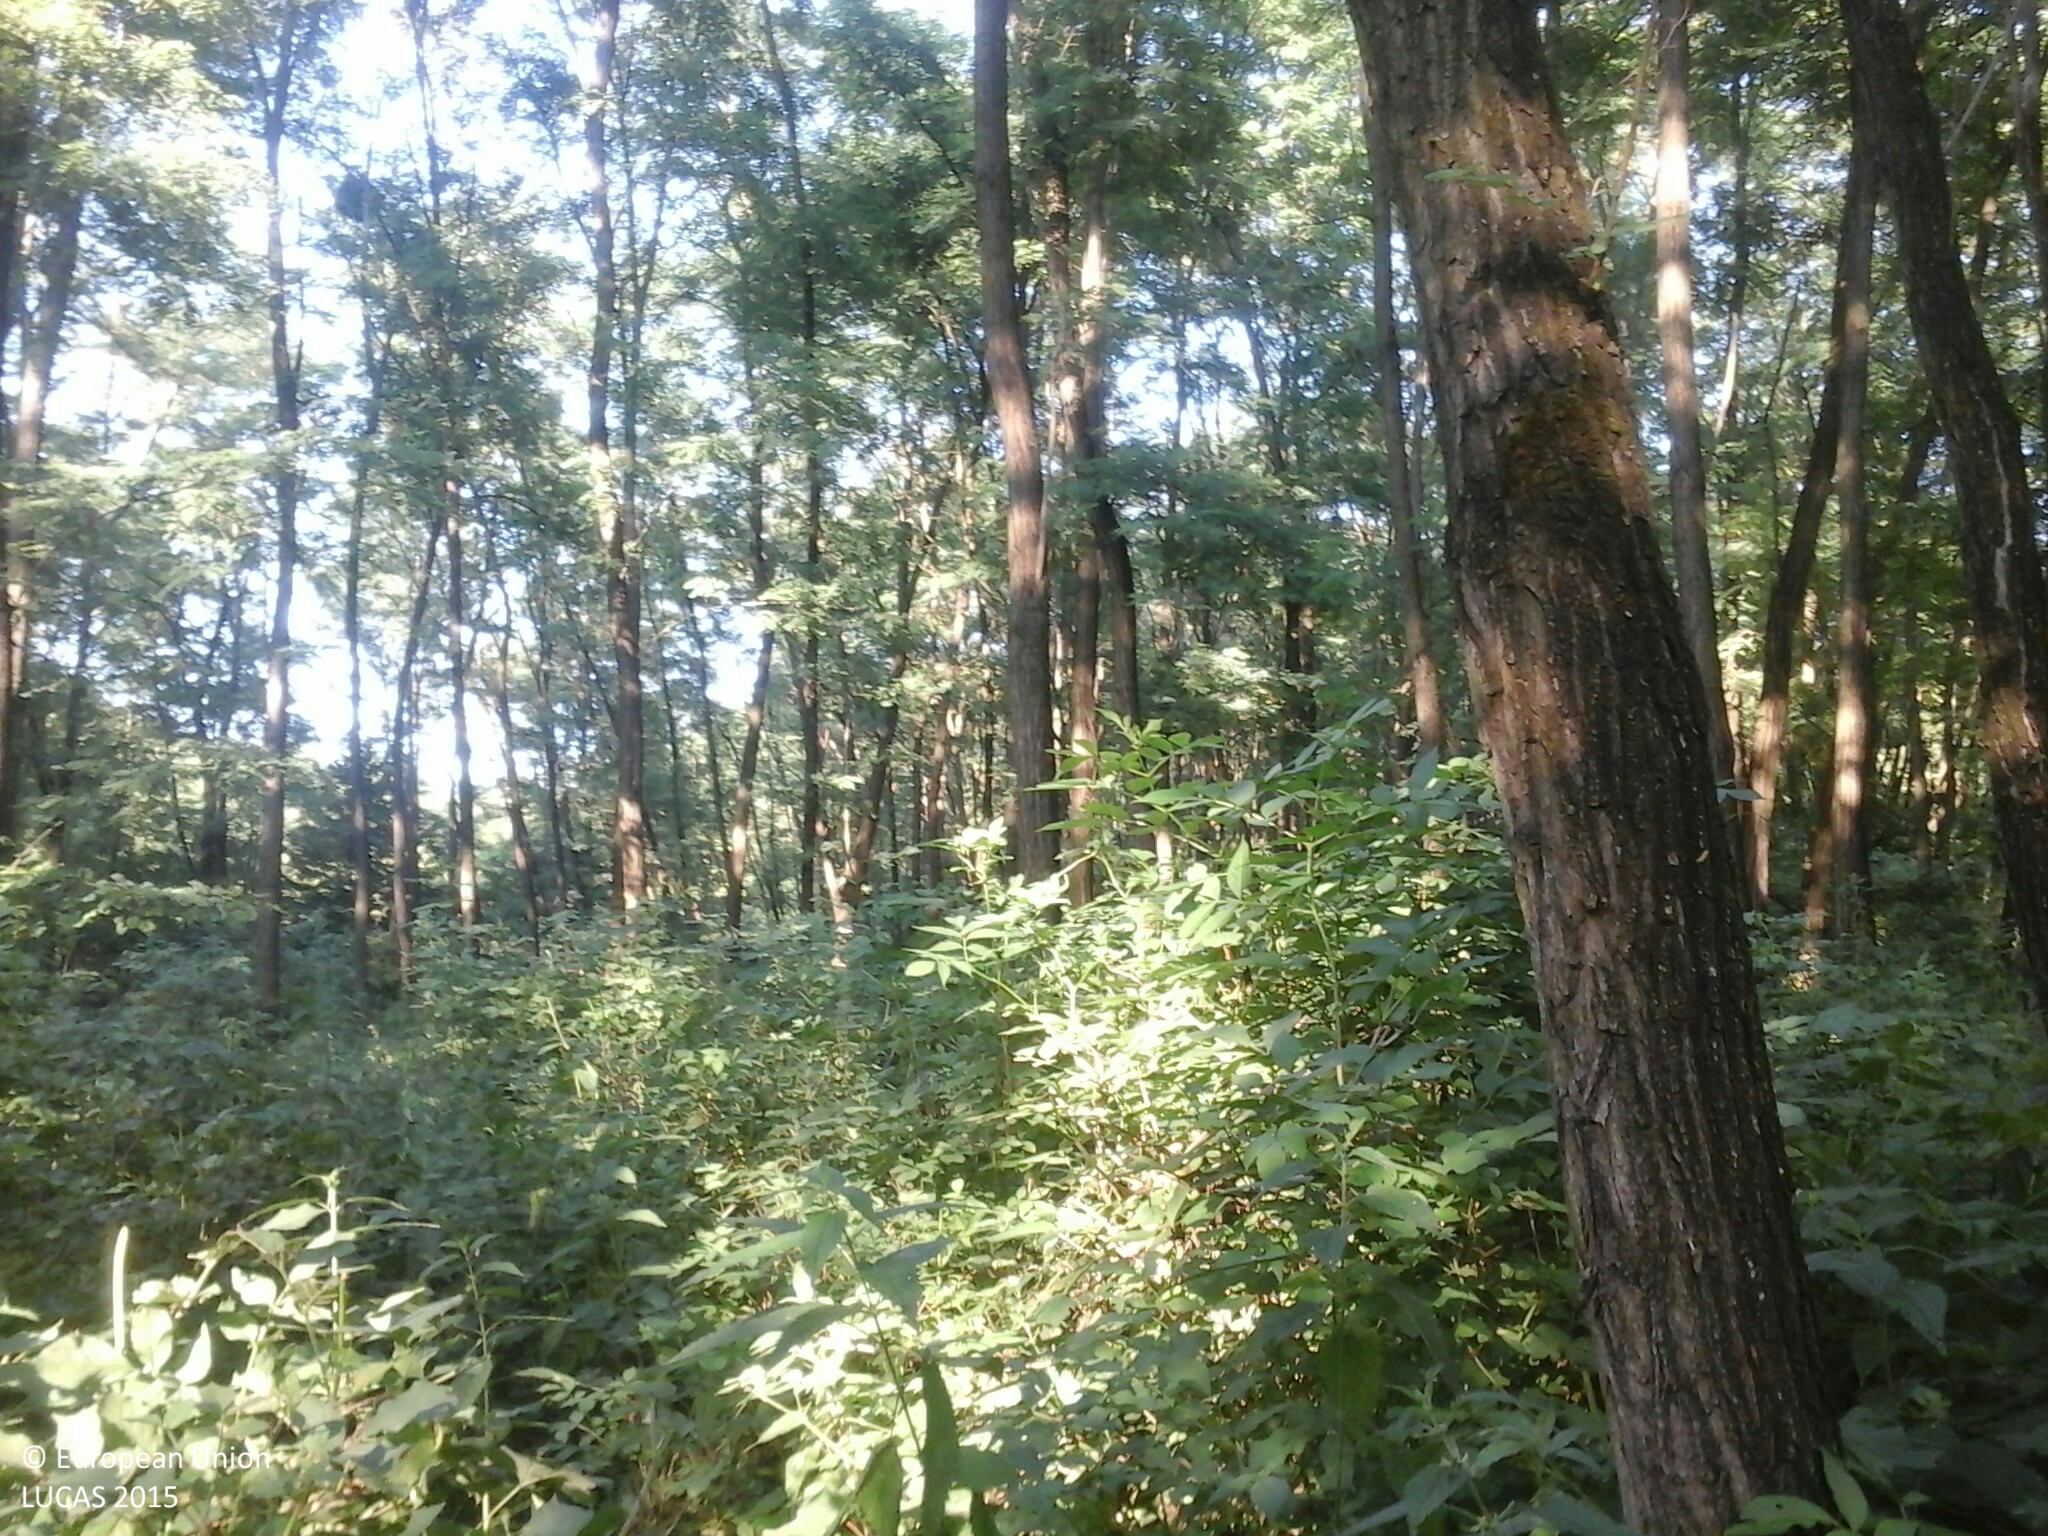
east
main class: Woodland
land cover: Broadleaved woodland
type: exotic forest
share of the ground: > 75 %
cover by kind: broadleaved forest trees 90 %, shrubs 10 %
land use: Forestry
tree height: > 5 m
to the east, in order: Broadleaved woodland; Ditches and canals; Broadleaved woodland
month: July
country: HU
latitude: 47.3659
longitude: 17.8352
